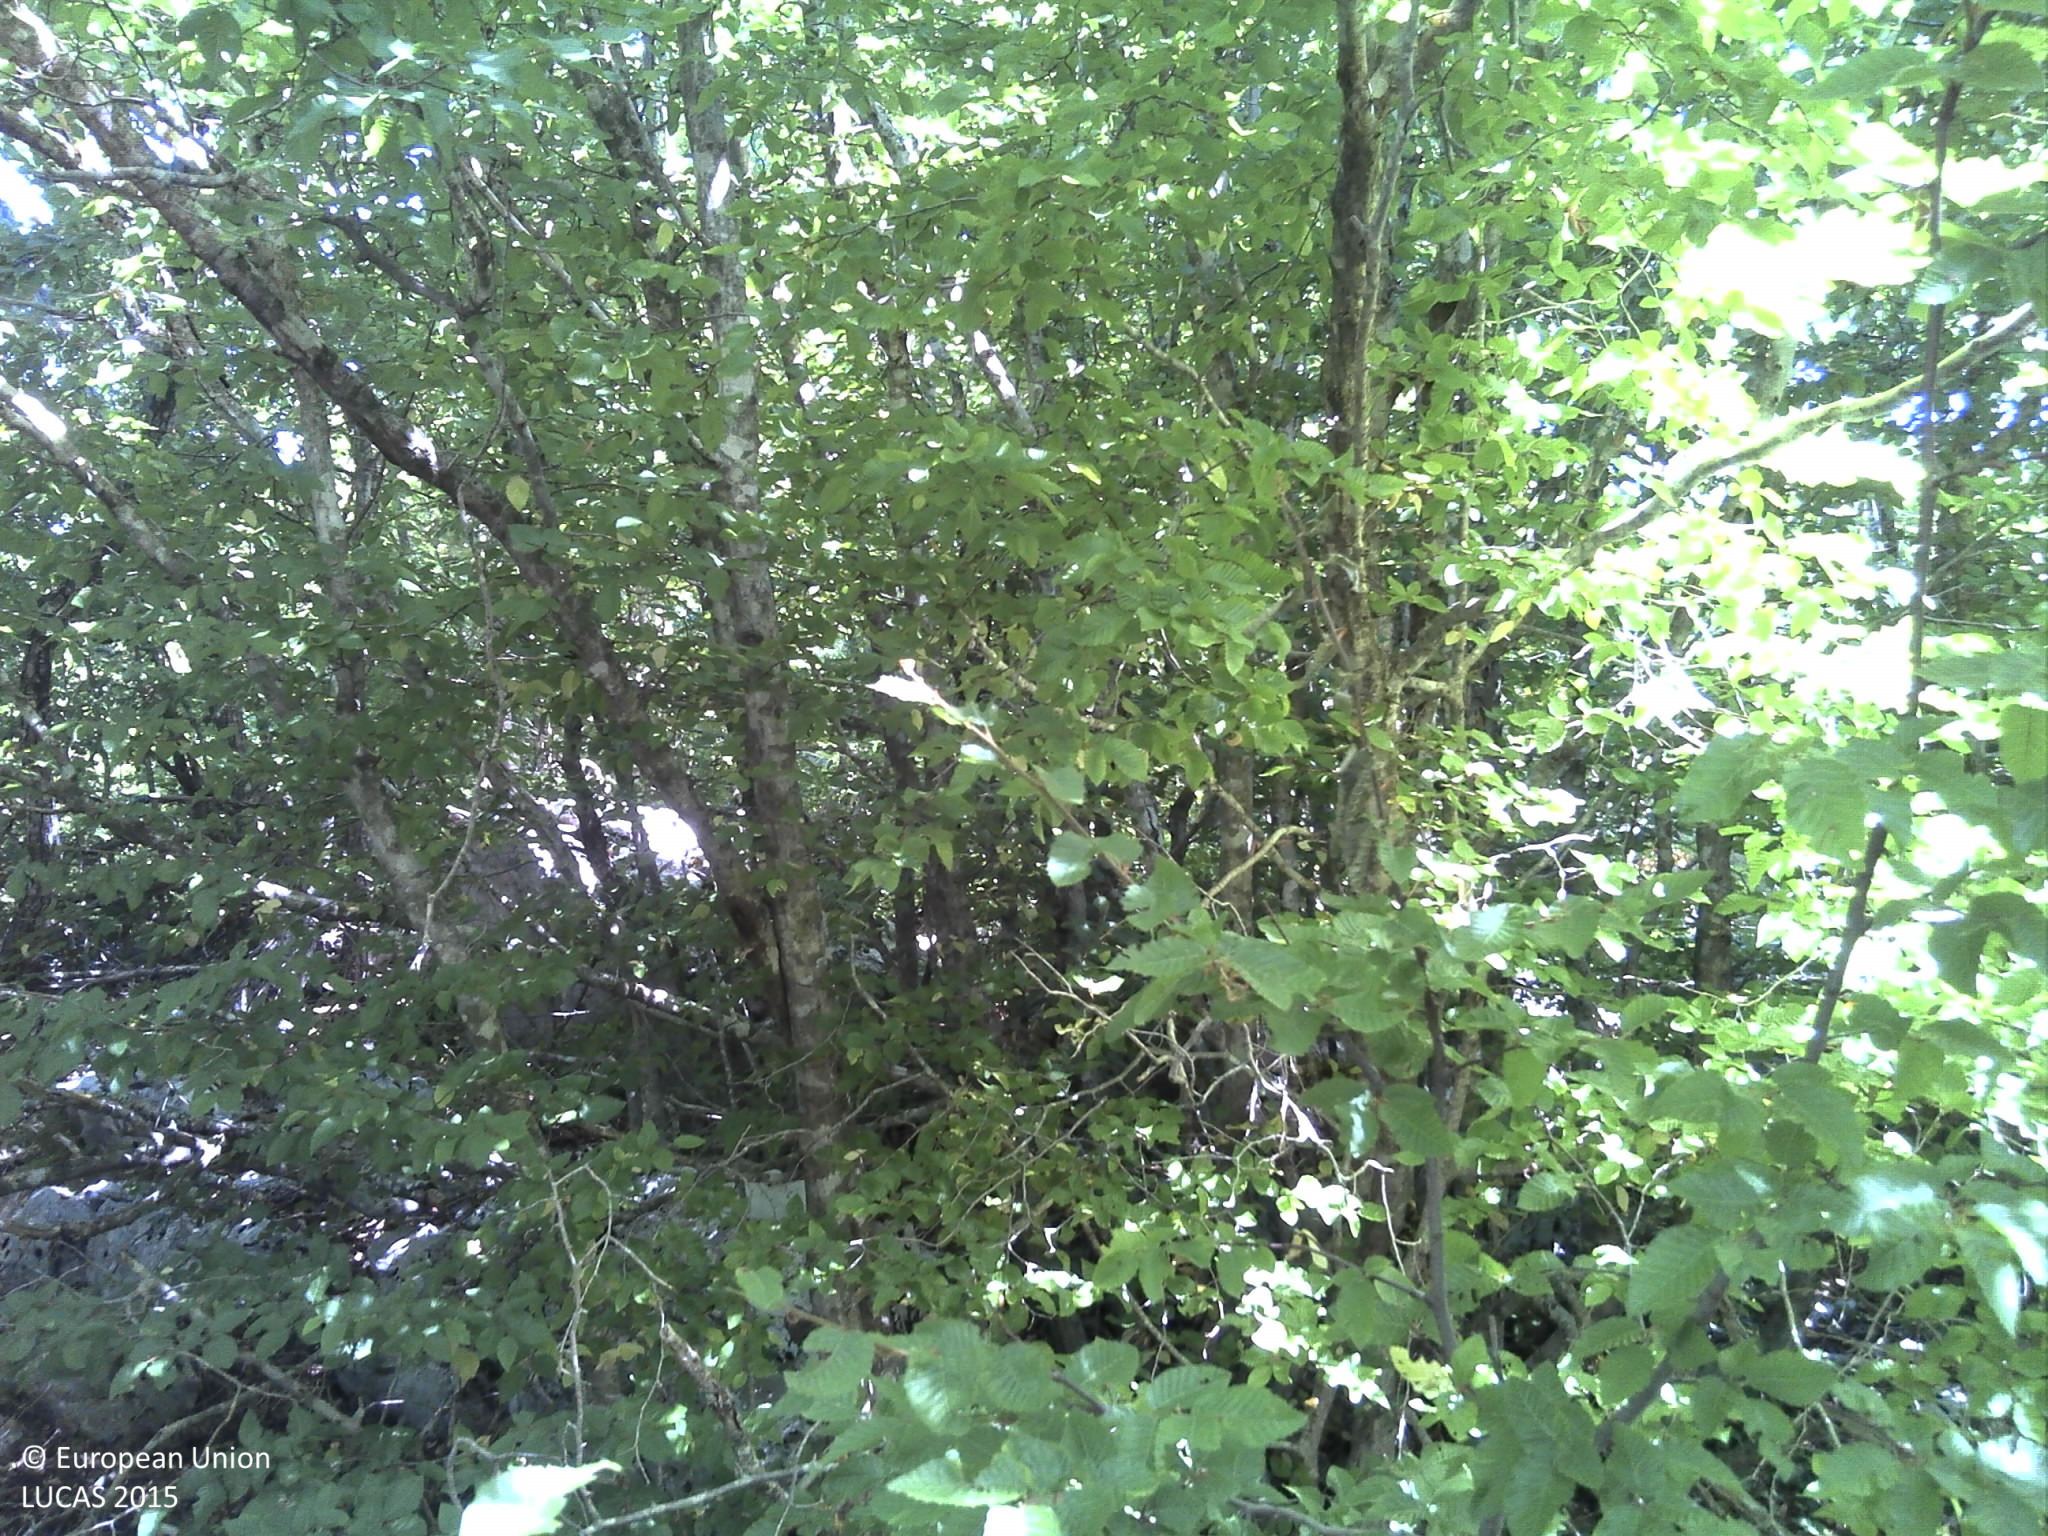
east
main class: Woodland
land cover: Broadleaved woodland
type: thermophilous deciduous forest
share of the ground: 25 - 50 %
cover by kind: broadleaved forest trees 50 %, shrubs 25 %, consolidated bare surface 15 %, herbaceous plants 5 %, lichens and mosses 5 %
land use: Semi-natural and natural areas not in use
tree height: > 5 m
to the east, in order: Broadleaved woodland; Shrubland with sparse tree cover; Grassland with sparse tree/shrub cover; Shrubland with sparse tree cover
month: July
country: HR
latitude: 43.5701
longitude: 17.0125
